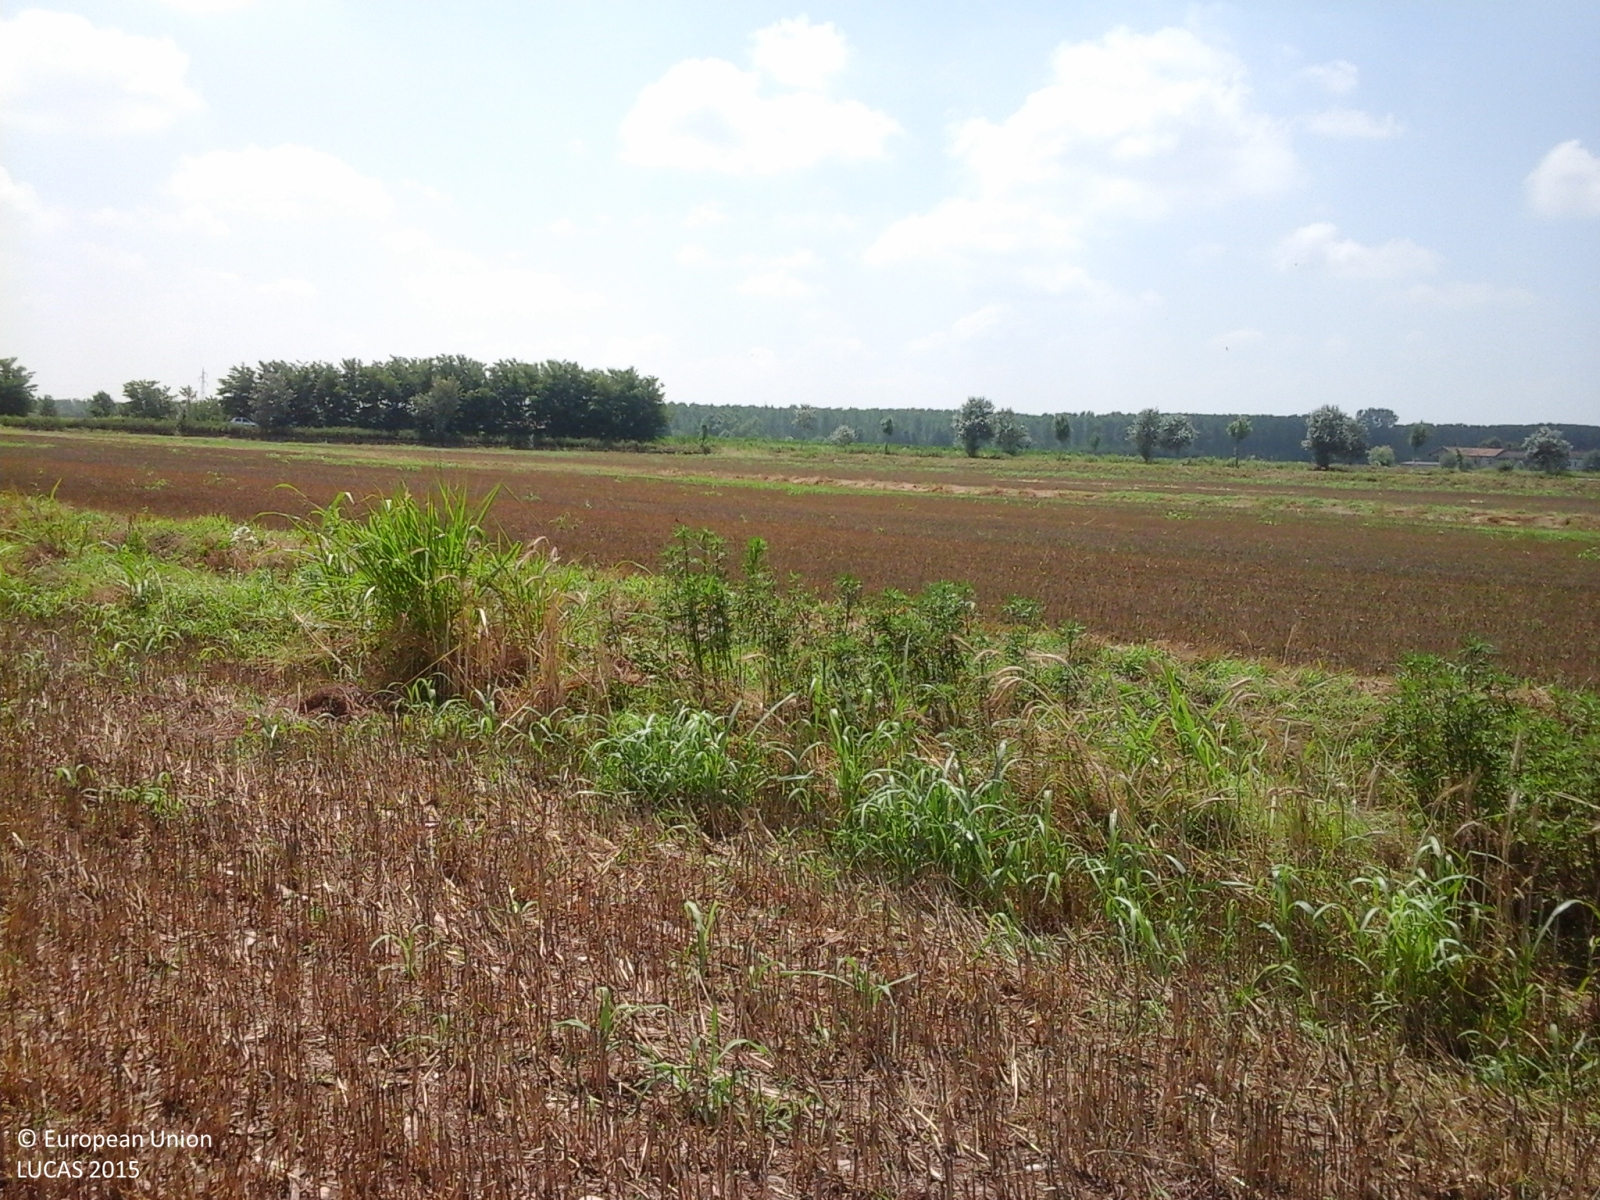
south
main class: Cropland
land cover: Common wheat
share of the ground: < 10 %
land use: Agriculture (excluding fallow land and kitchen gardens)
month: June
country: IT
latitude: 45.4617
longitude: 8.8126
